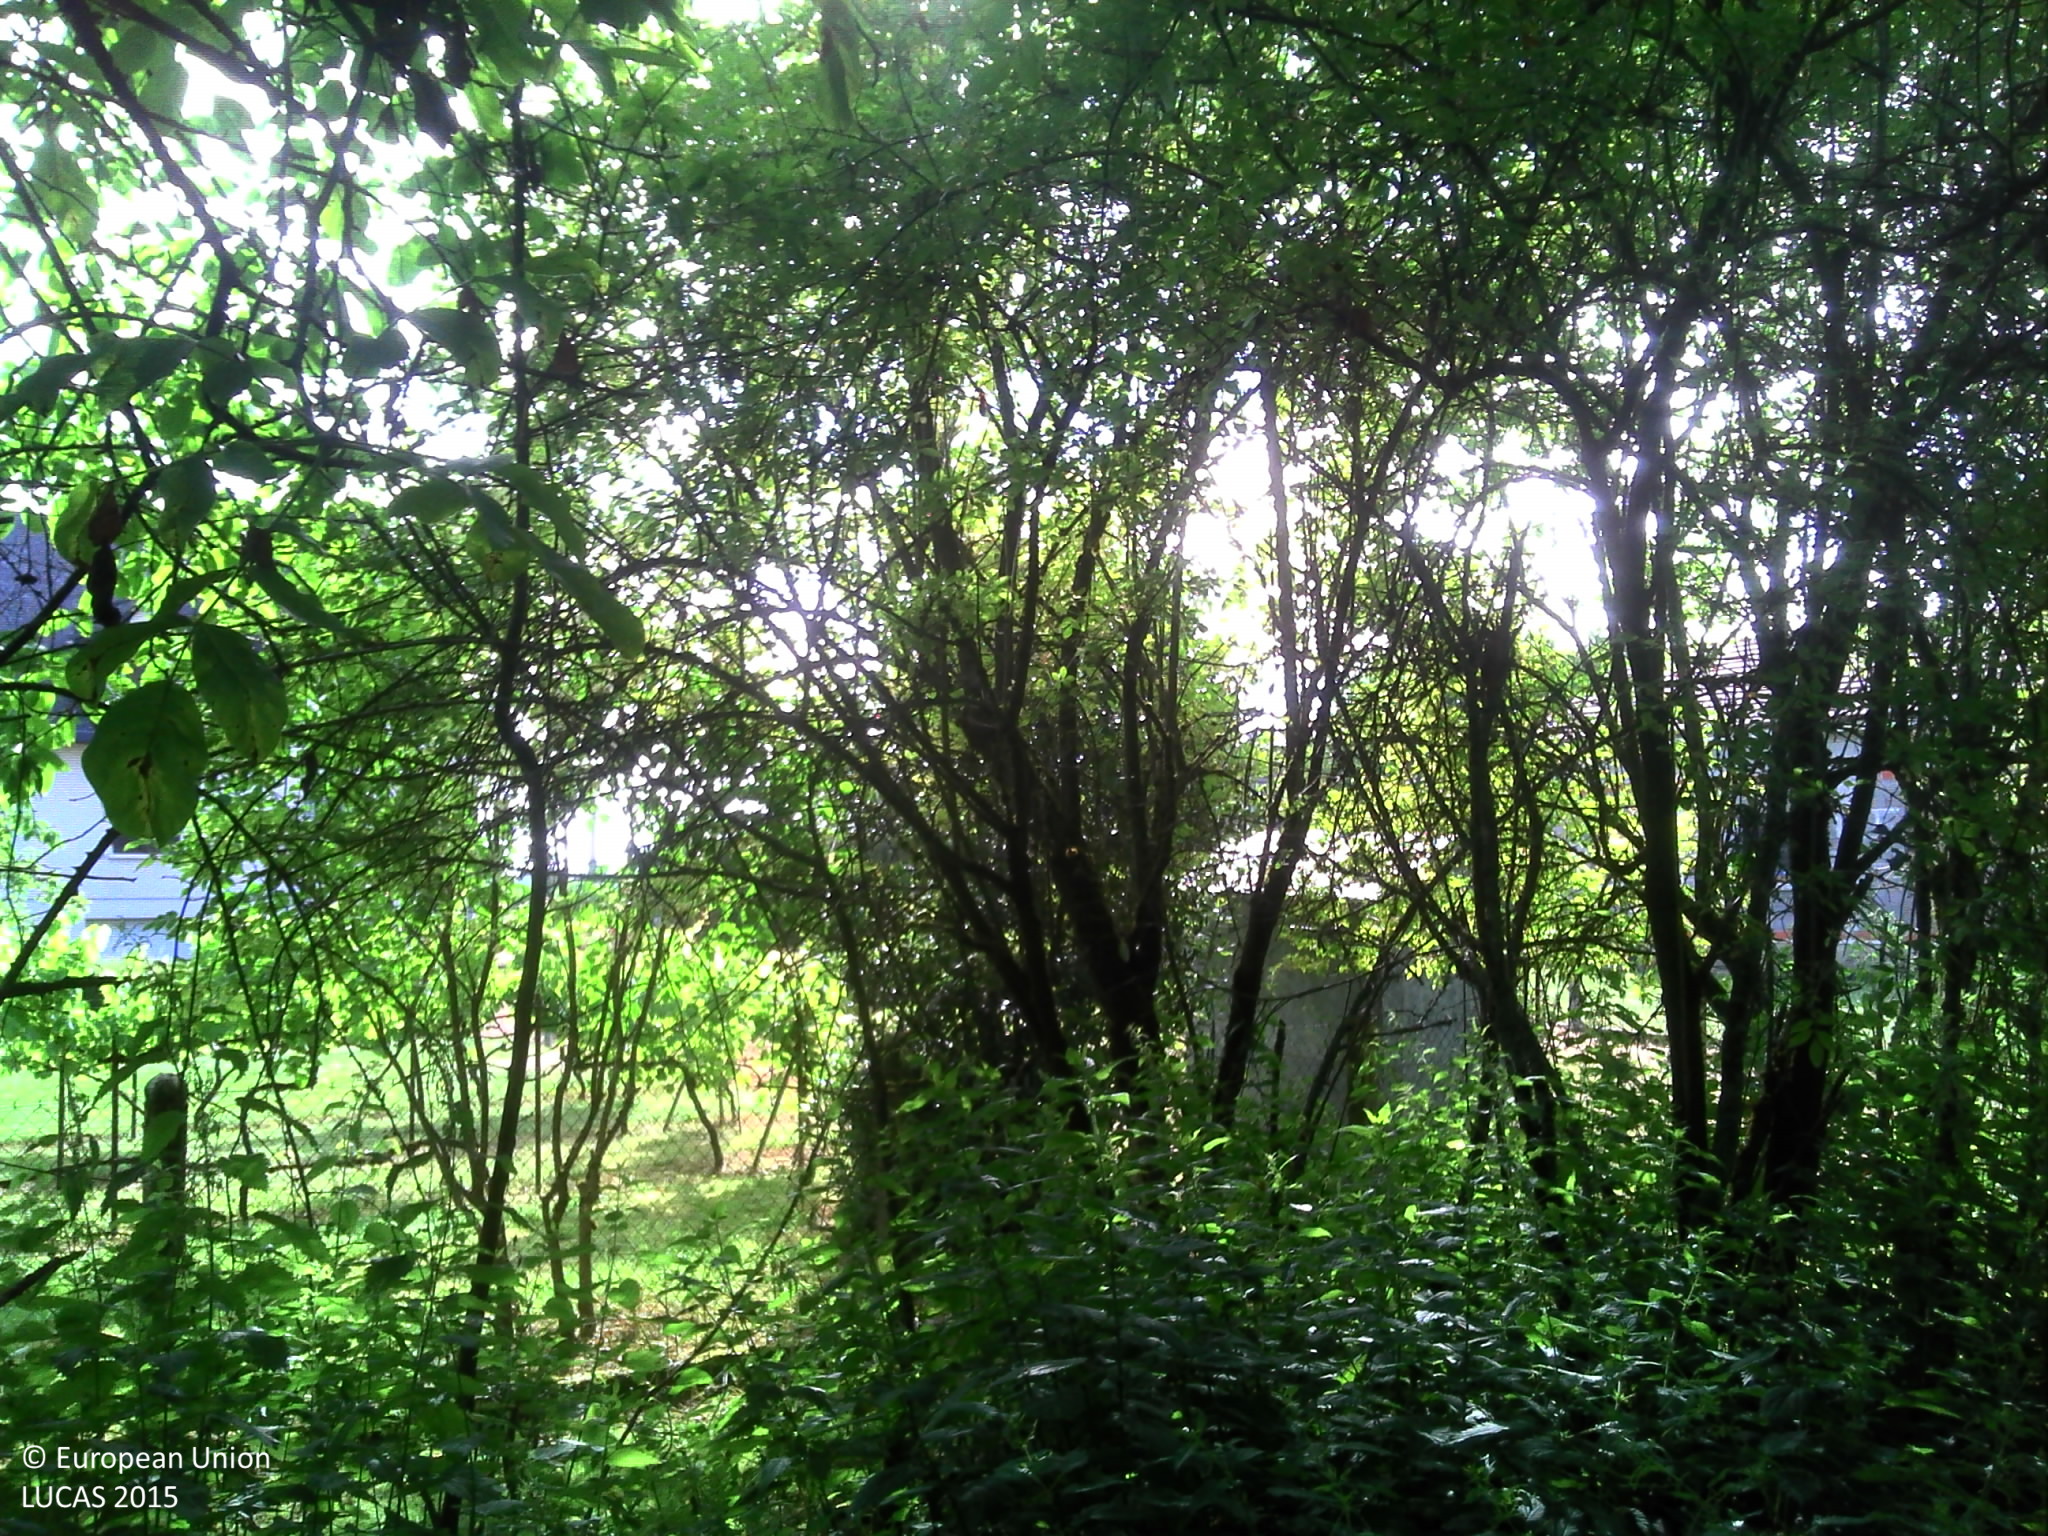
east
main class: Woodland
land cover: Other mixed woodland
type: mesophytic deciduous forest
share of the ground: > 75 %
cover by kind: broadleaved forest trees 50 %, coniferous forest trees 25 %, herbaceous plants 25 %
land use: Semi-natural and natural areas not in use
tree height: > 5 m
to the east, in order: Other mixed woodland; Artificial constructions in urban areas; Clovers
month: June
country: FR
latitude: 46.4715
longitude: 3.9965
